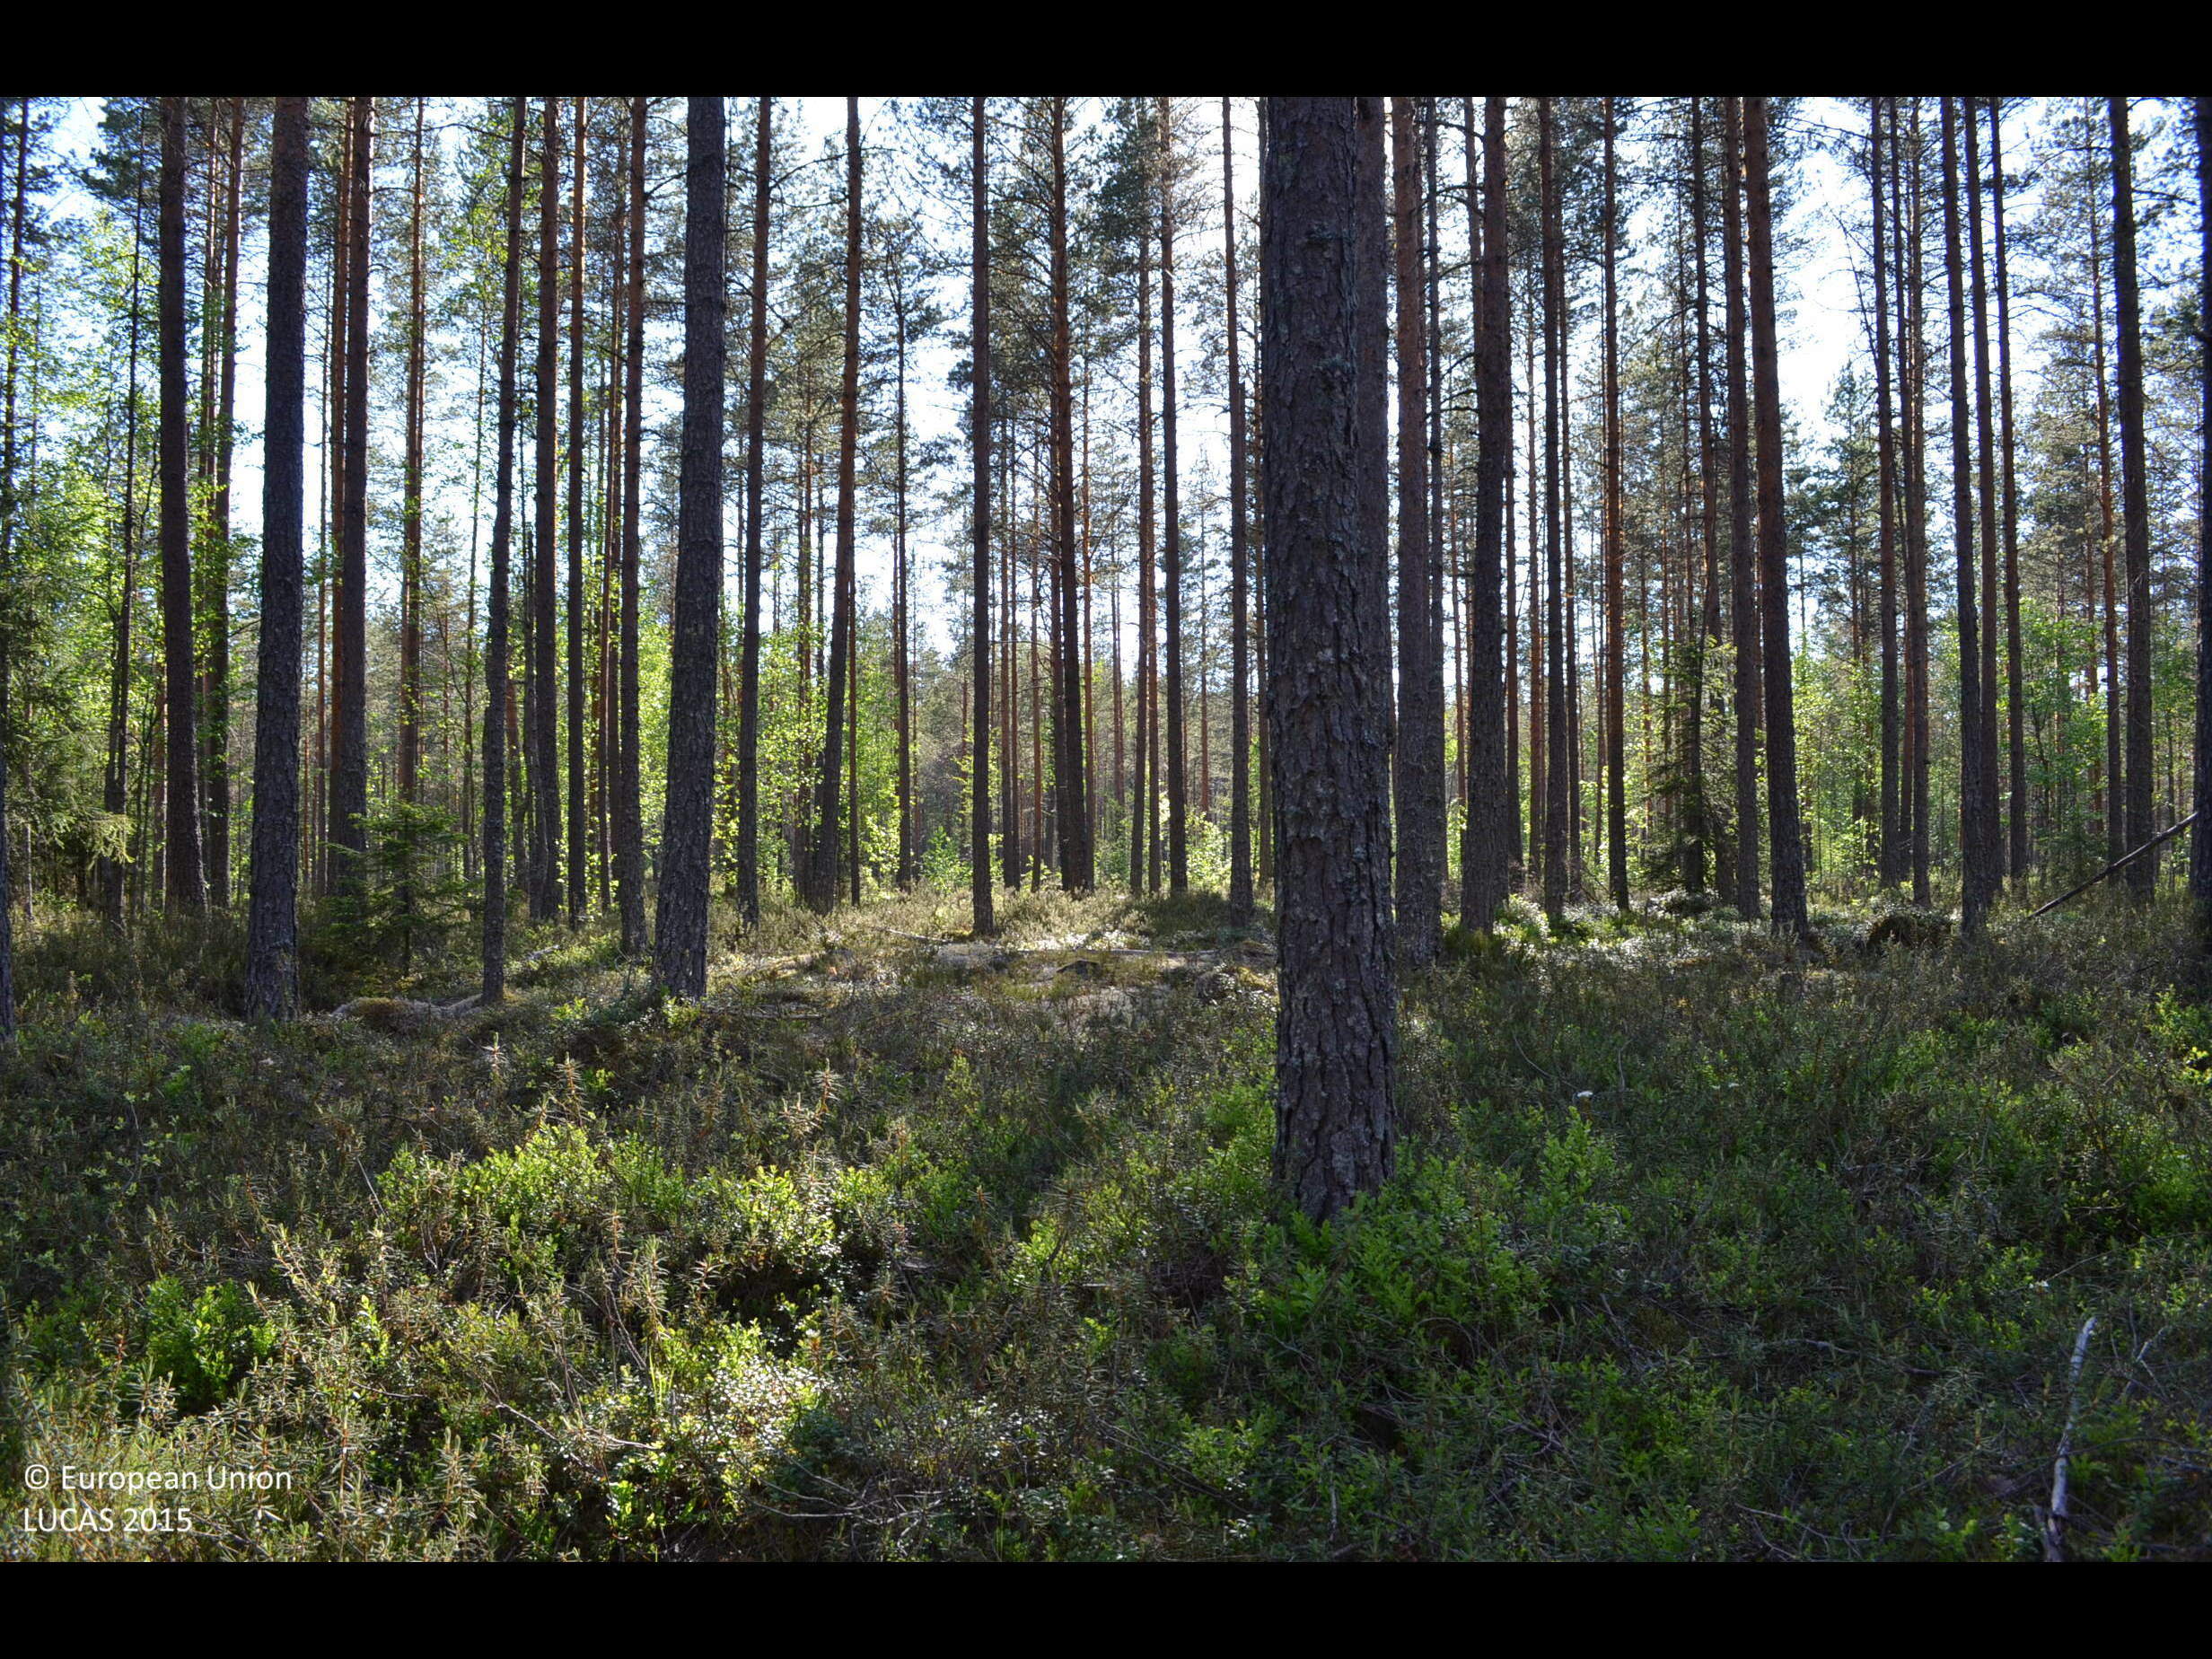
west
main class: Woodland
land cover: Pine dominated coniferous woodland
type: boreal forest
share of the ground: 50 - 75 %
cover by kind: coniferous forest trees 70 %, shrubs 30 %
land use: Forestry
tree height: > 5 m
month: June
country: FI
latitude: 61.8910
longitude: 23.2958
